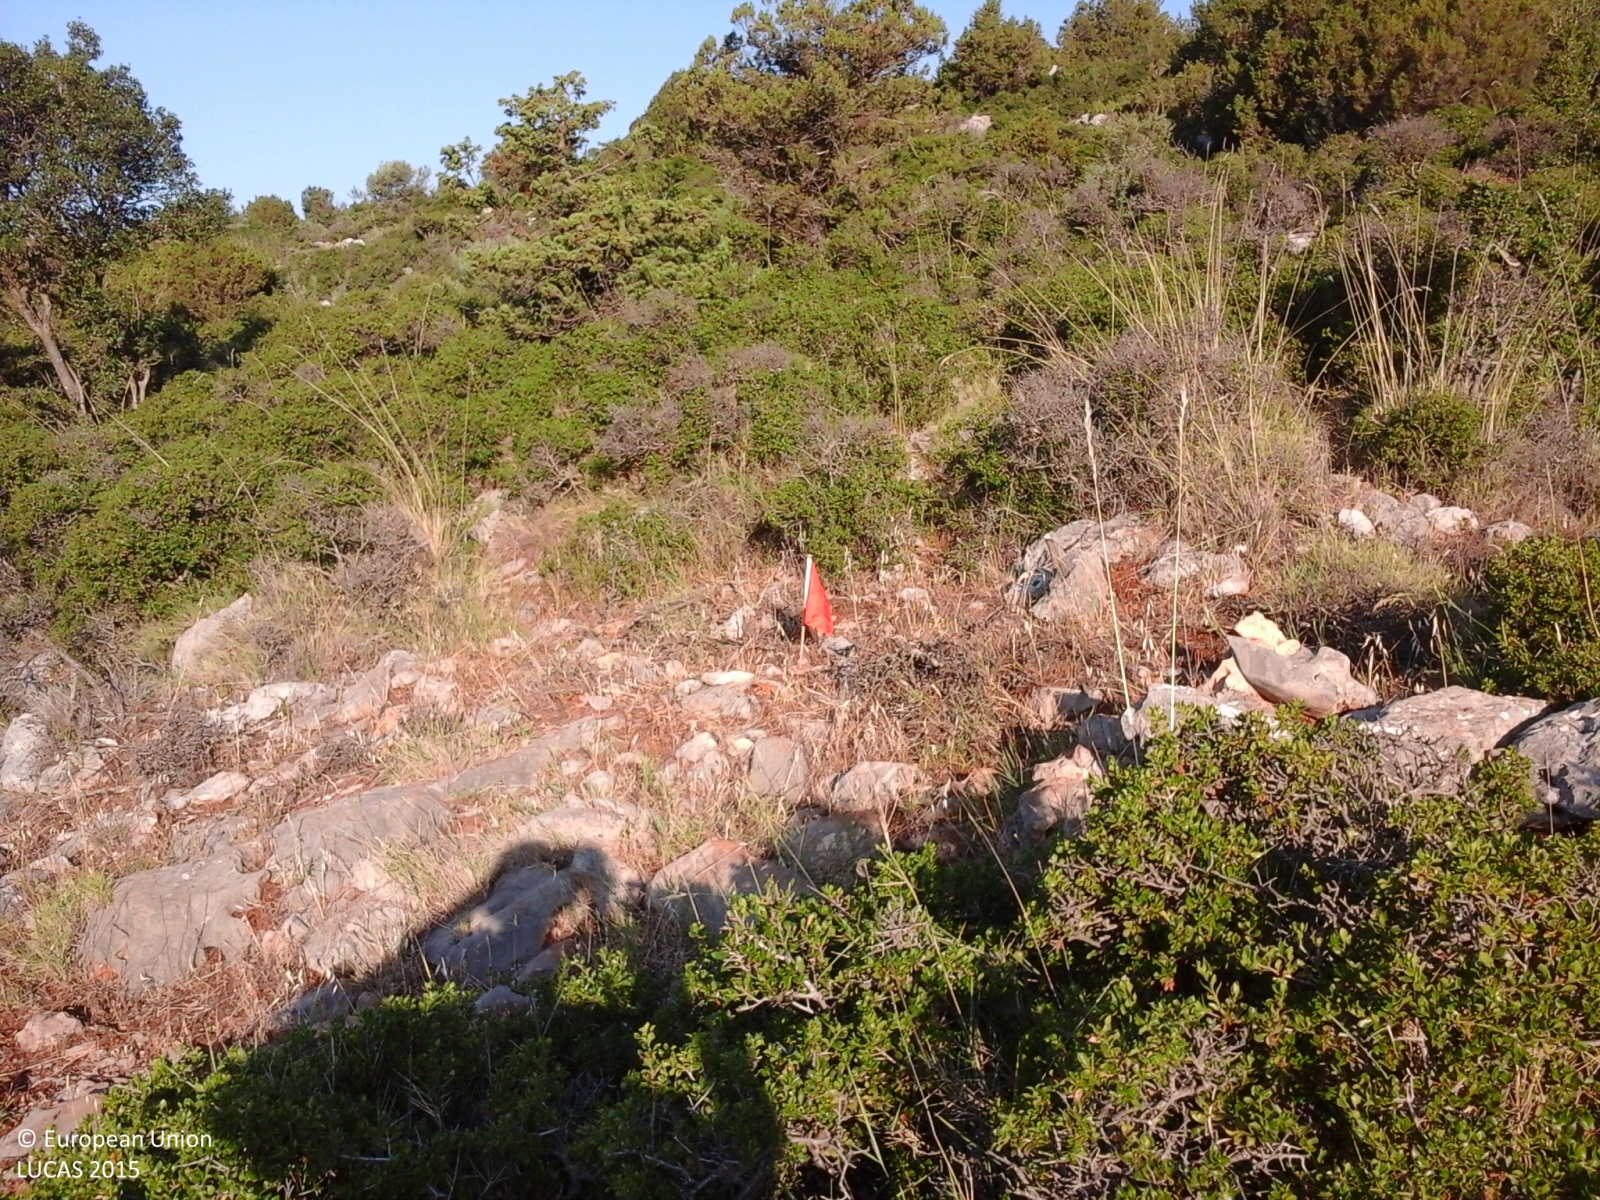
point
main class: Shrubland
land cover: Shrubland with sparse tree cover
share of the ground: > 75 %
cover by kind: shrubs 75 %, herbaceous plants 10 %, unconsolidated bare surface 10 %, coniferous forest trees 5 %
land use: Semi-natural and natural areas not in use
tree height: > 5 m
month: June
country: GR
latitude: 38.4580
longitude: 22.5010
